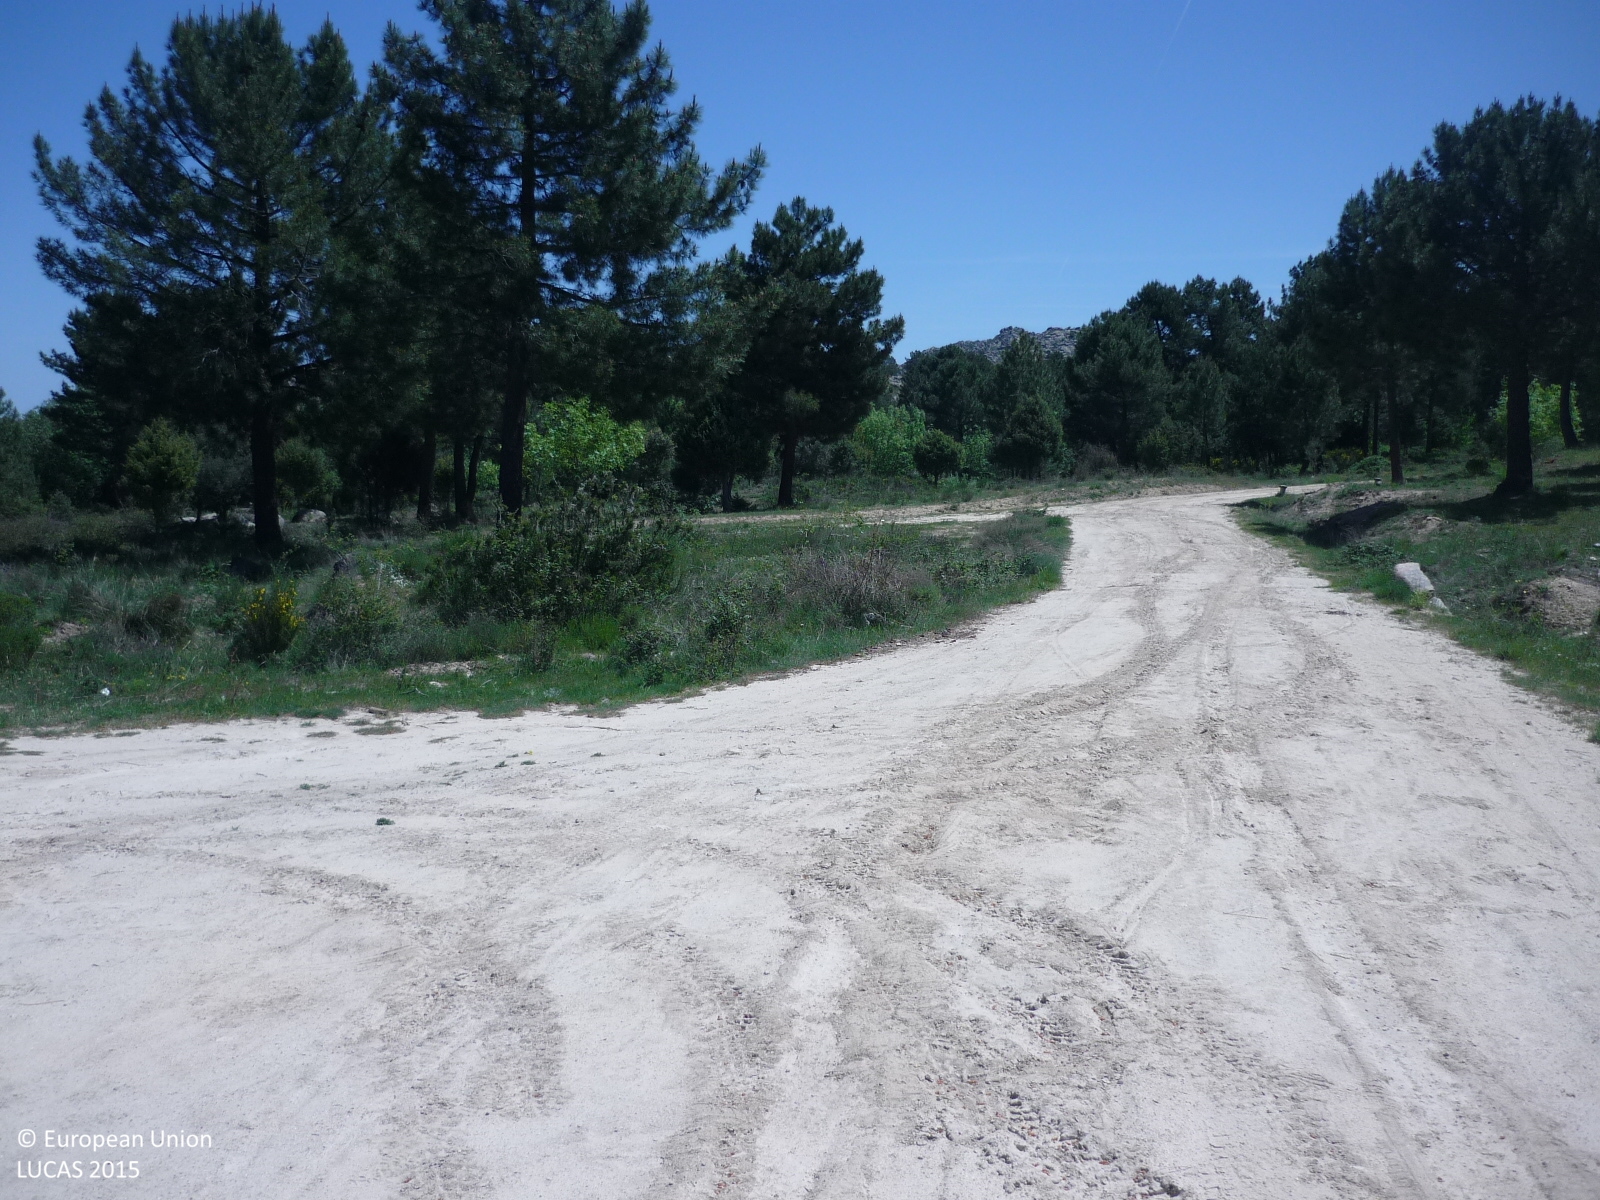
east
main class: Woodland
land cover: Broadleaved woodland
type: broadleaved evergreen forest
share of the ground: 25 - 50 %
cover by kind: herbaceous plants 60 %, broadleaved forest trees 40 %
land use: Forestry
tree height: > 5 m
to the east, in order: Broadleaved woodland; Grassland with sparse tree/shrub cover; Dry stone walls; Grassland without tree/shrub cover; Tracks; Grassland without tree/shrub cover; Abandoned hedges; Dry stone walls; Grassland with sparse tree/shrub cover; Dry stone walls; Grassland with sparse tree/shrub cover
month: May
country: ES
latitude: 40.9037
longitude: -3.6353
